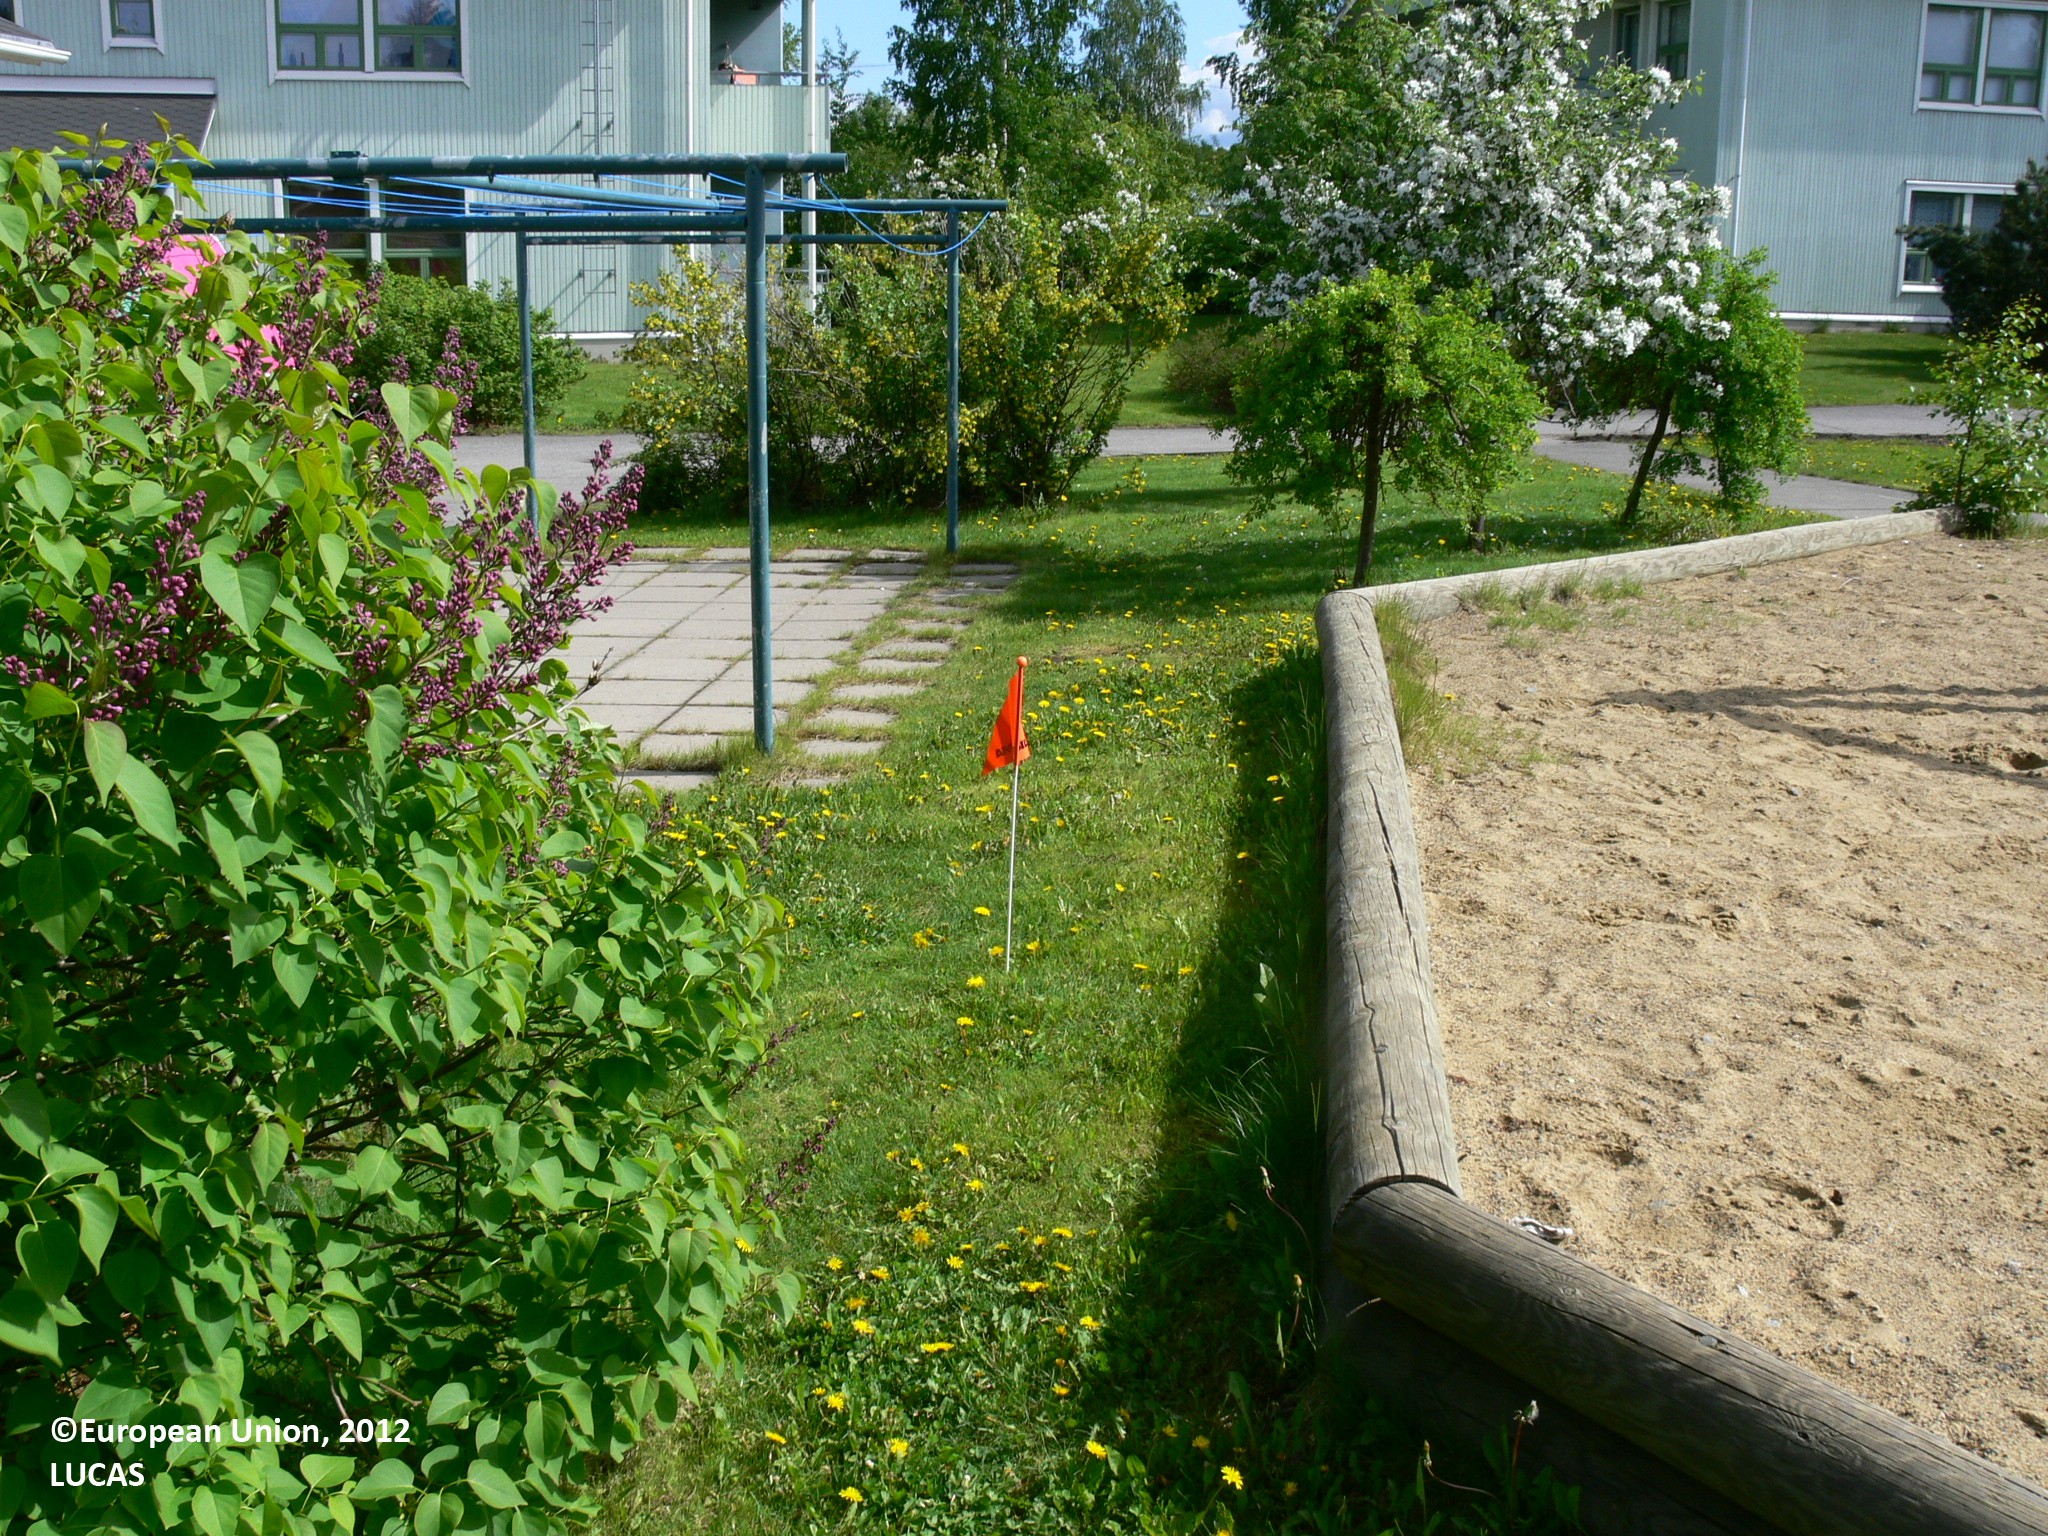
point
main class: Grassland
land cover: Grassland with sparse tree/shrub cover
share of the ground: 50 - 75 %
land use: Residential
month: June
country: FI
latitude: 62.5996
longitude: 29.8268
